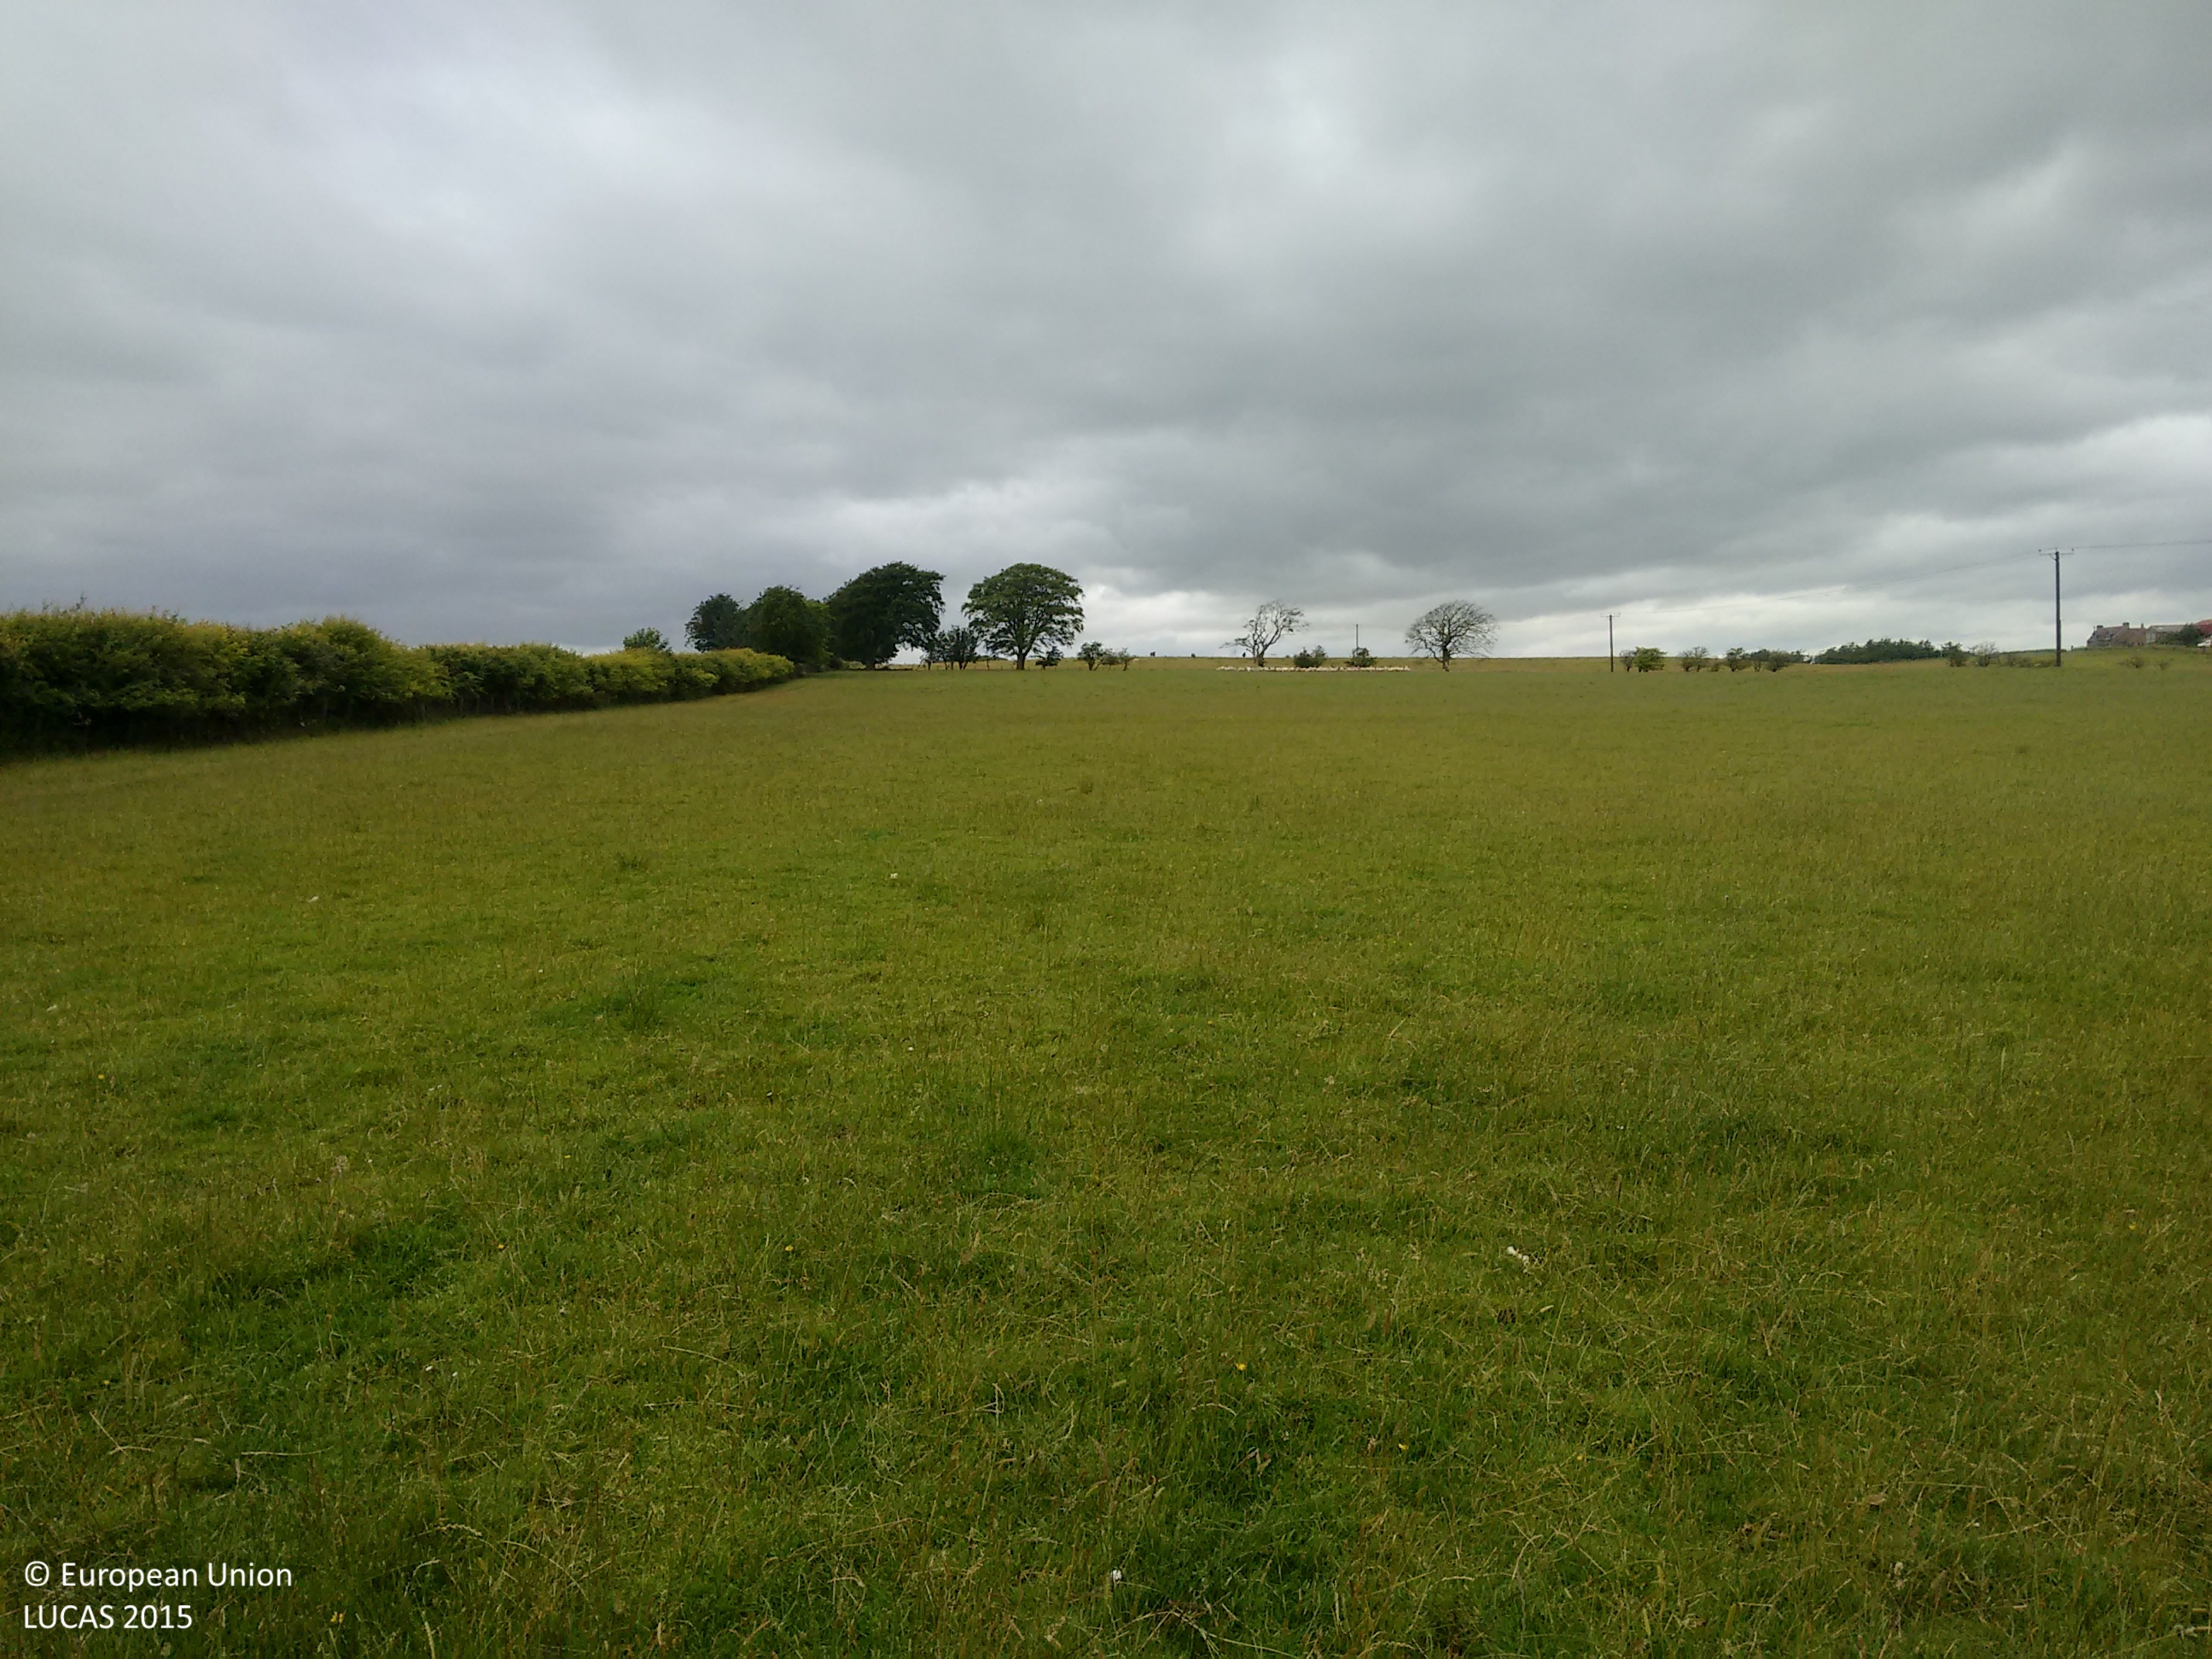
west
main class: Grassland
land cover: Grassland without tree/shrub cover
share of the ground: > 75 %
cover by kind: herbaceous plants 100 %
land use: Agriculture (excluding fallow land and kitchen gardens)
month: August
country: GB
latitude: 56.2625
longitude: -2.8999
